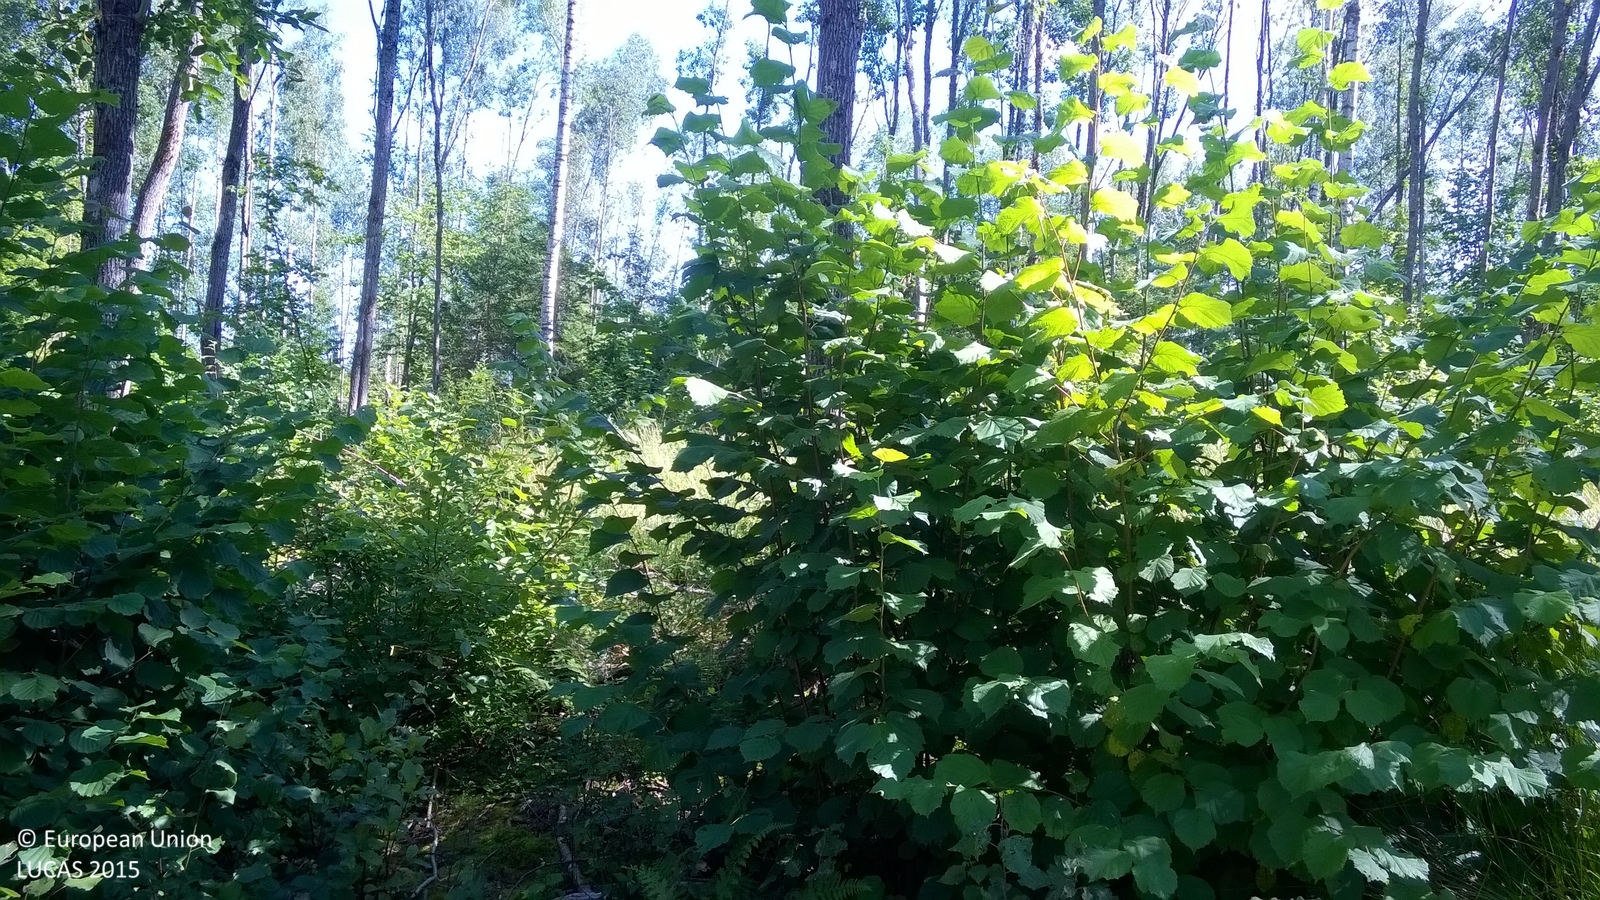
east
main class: Woodland
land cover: Broadleaved woodland
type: non-riverine alder, birch or aspen forest
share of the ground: > 75 %
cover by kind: broadleaved forest trees 80 %, shrubs 10 %, herbaceous plants 10 %
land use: Forestry
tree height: > 5 m
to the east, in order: Broadleaved woodland; Spruce dominated mixed woodland; Shrubland with sparse tree cover; Spruce dominated mixed woodland
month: August
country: LV
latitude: 57.2452
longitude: 25.4440
